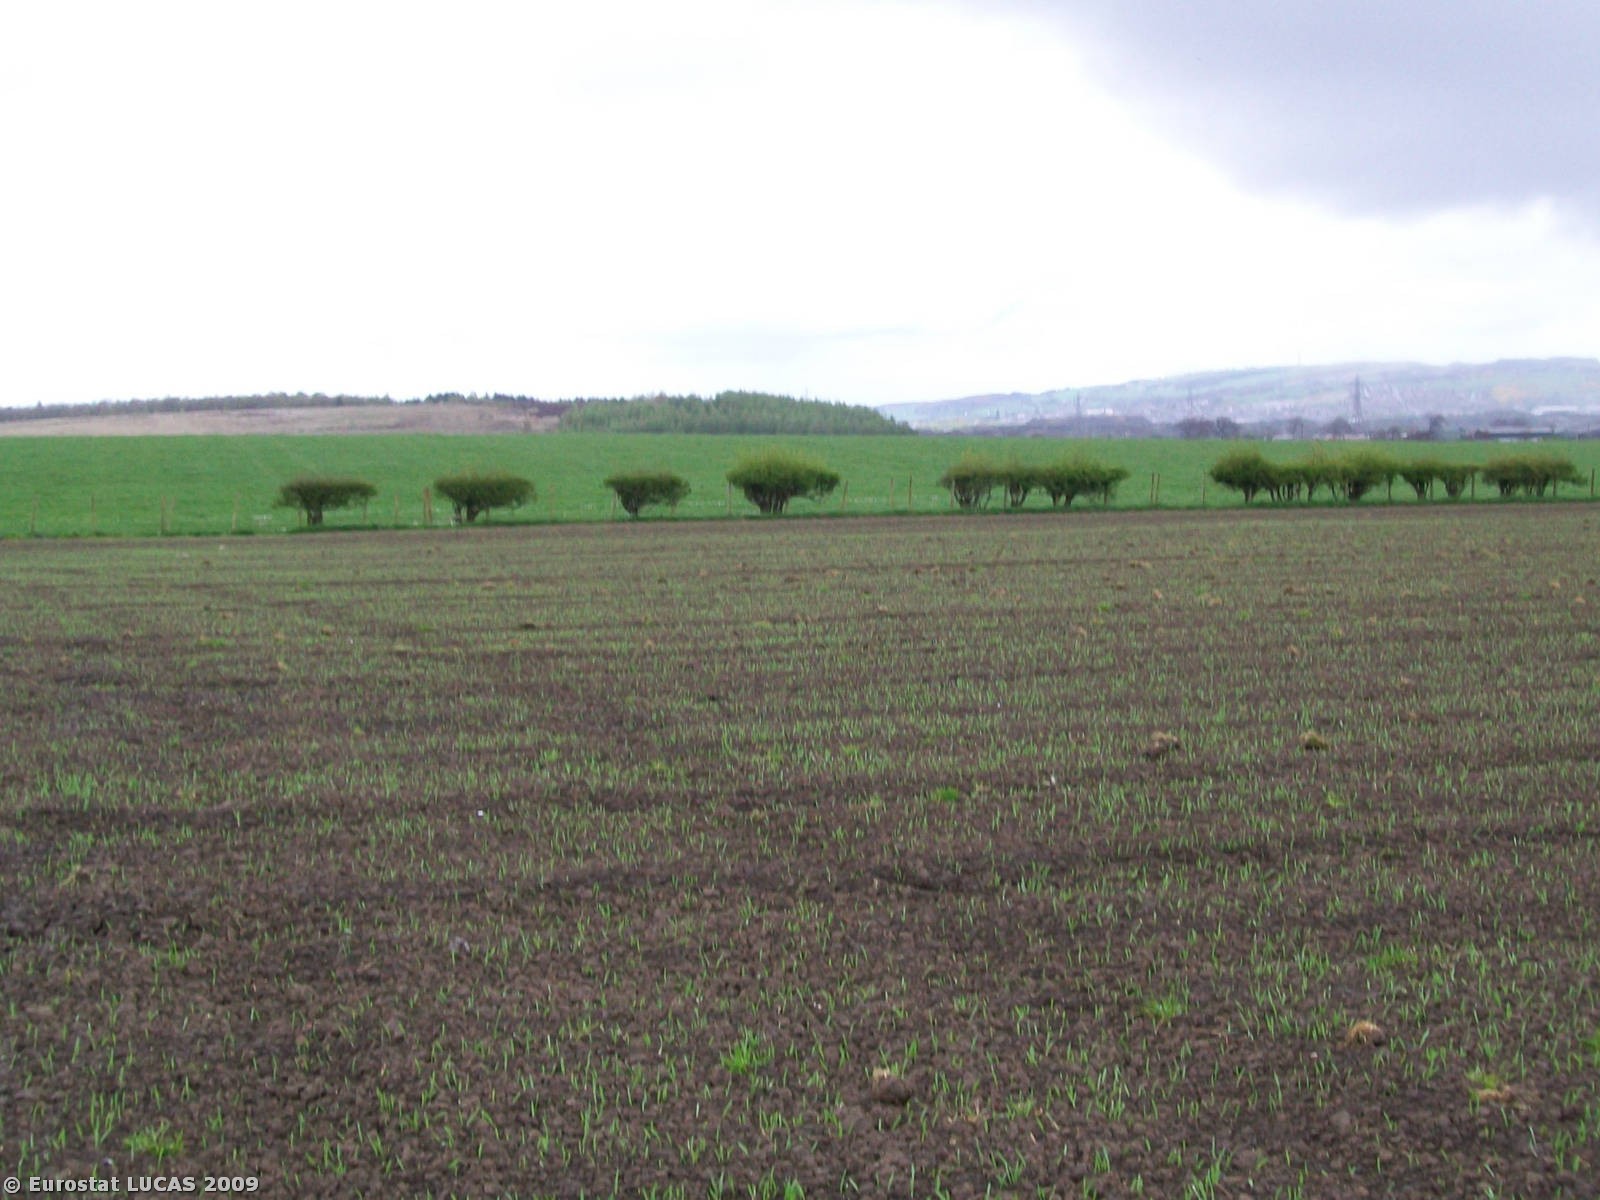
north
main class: Cropland
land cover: Barley
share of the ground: > 75 %
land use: Agriculture (excluding fallow land and kitchen gardens)
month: April
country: GB
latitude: 55.8562
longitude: -3.6437
